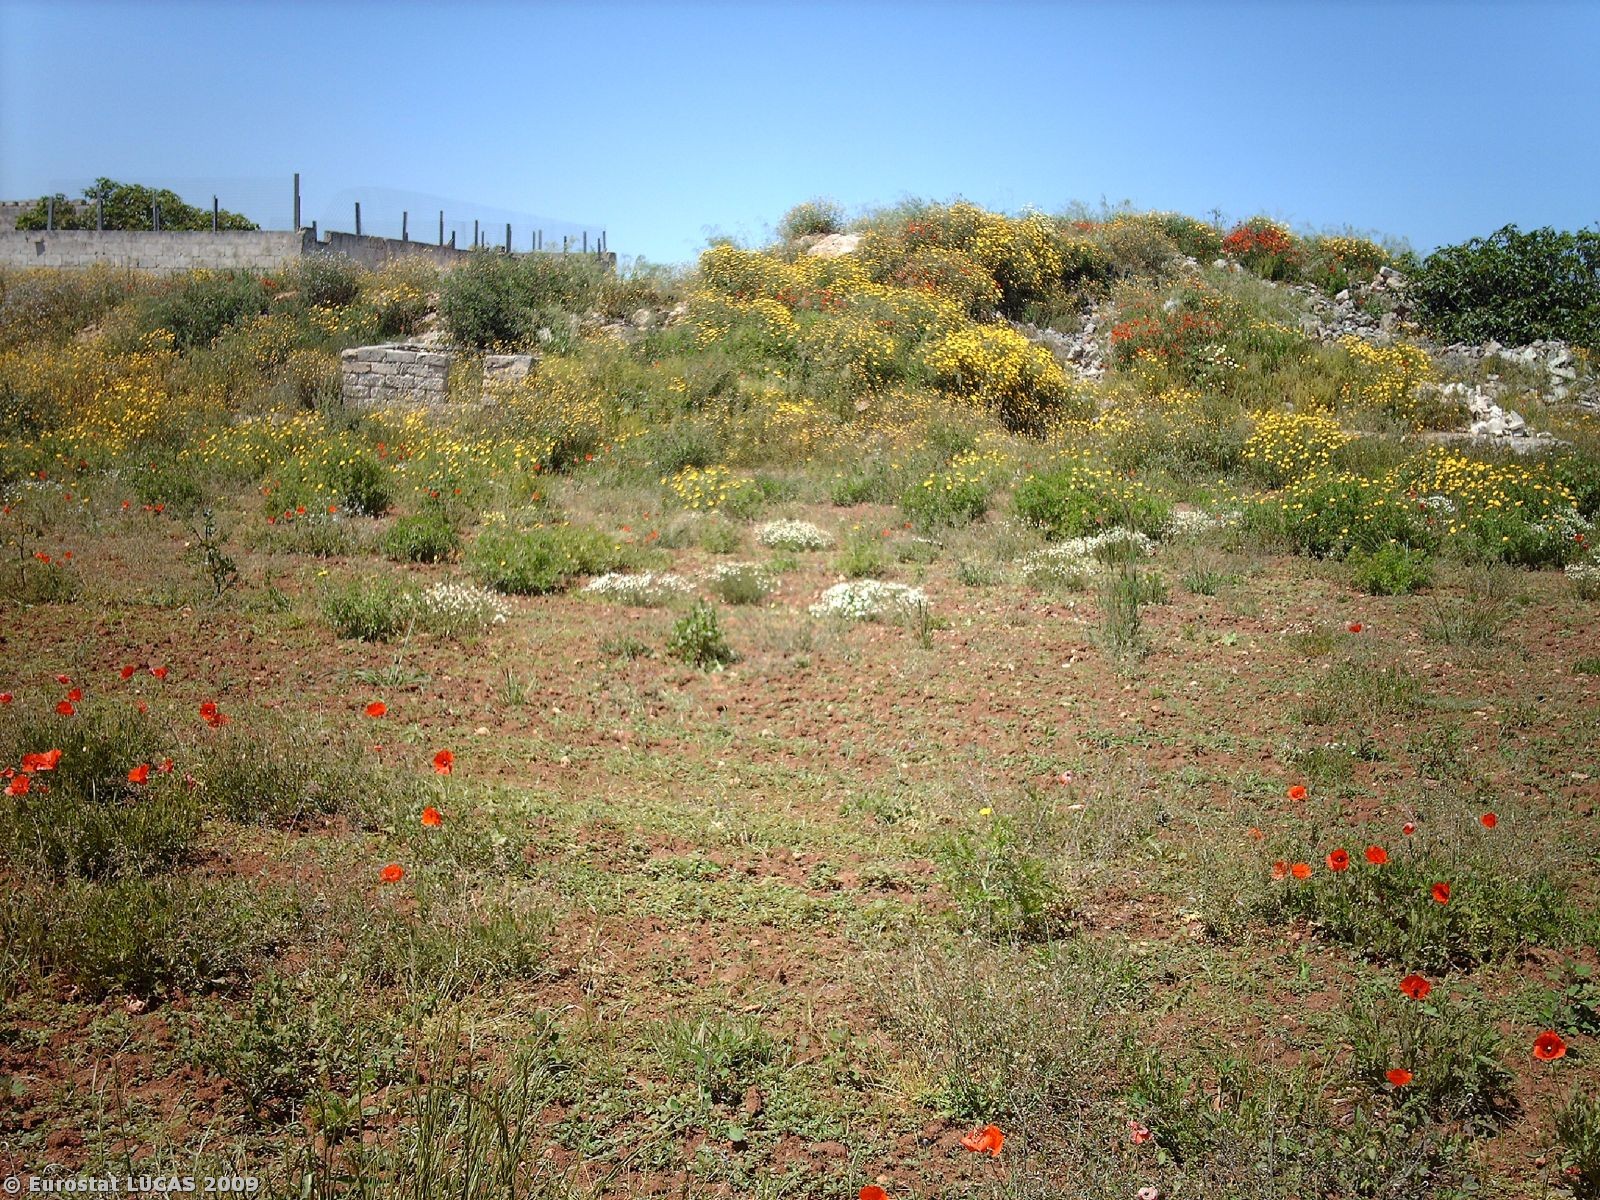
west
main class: Grassland
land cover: Spontaneously vegetated surfaces
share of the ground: > 75 %
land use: Fallow land
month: May
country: IT
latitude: 40.7916
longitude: 17.5744
